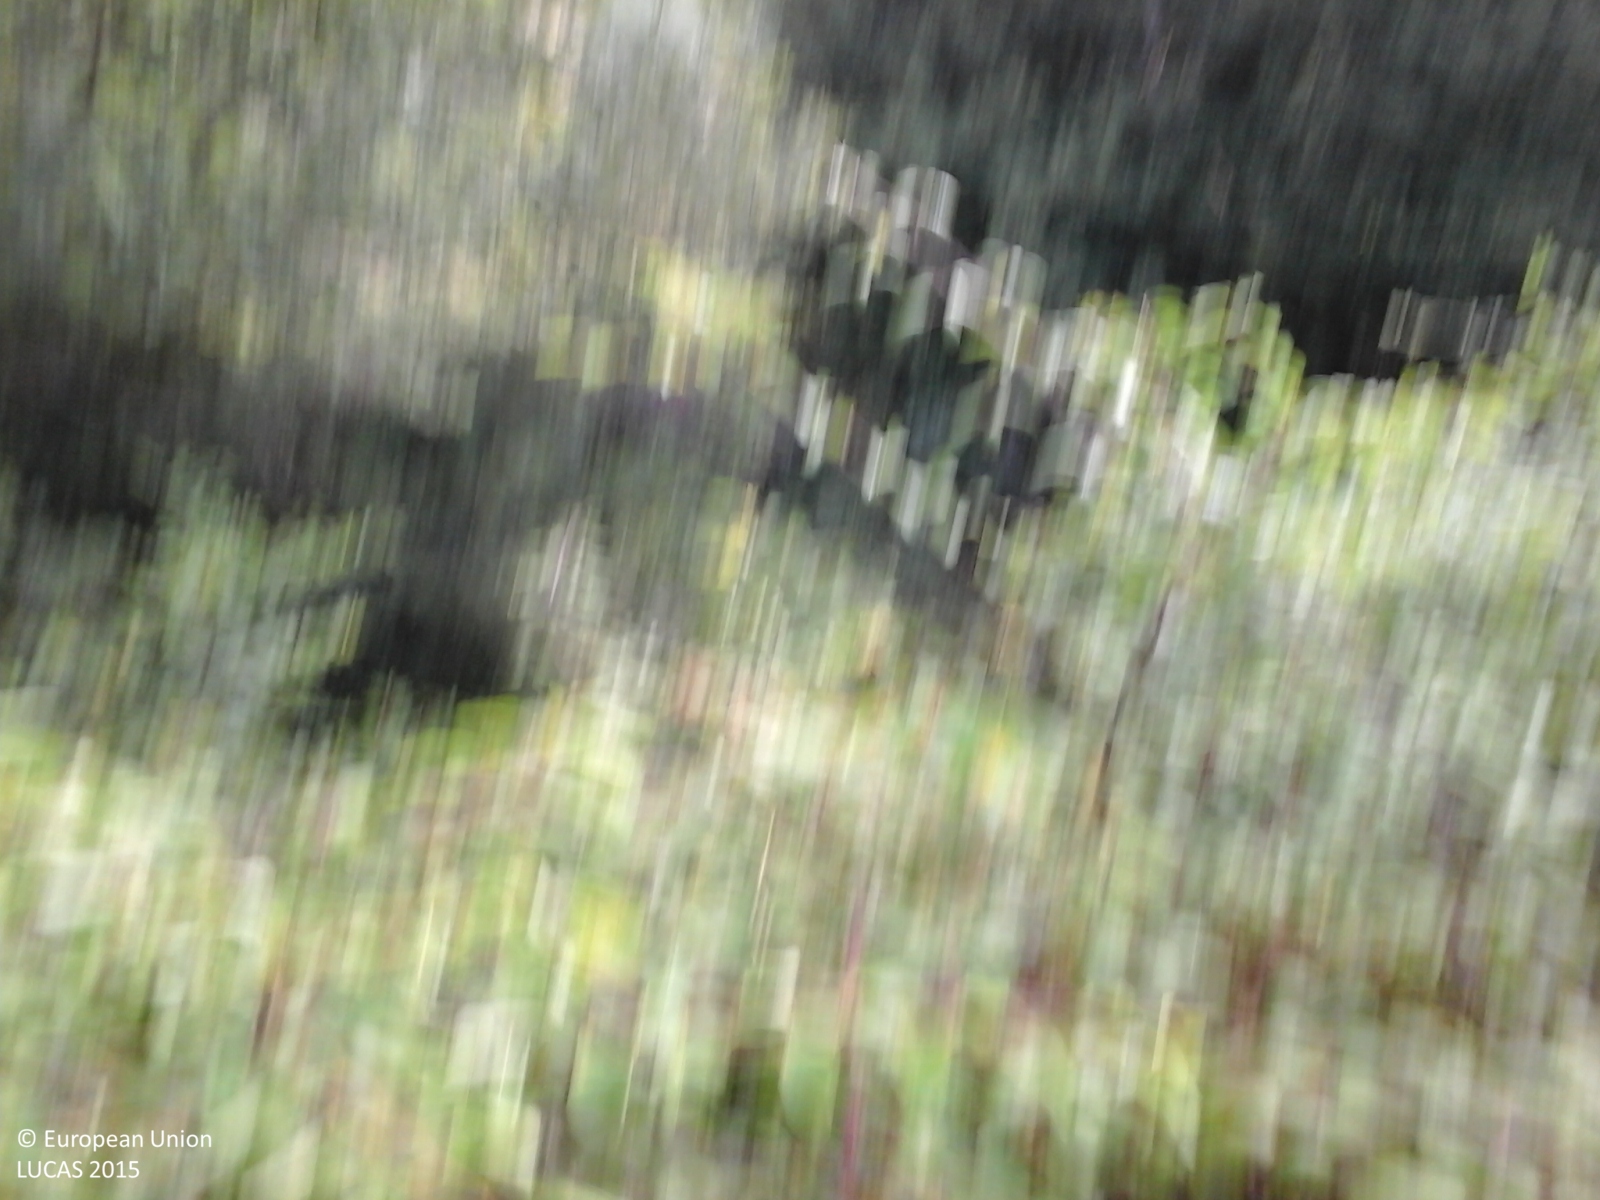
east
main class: Woodland
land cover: Broadleaved woodland
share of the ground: > 75 %
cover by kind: broadleaved forest trees 85 %, shrubs 15 %
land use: Semi-natural and natural areas not in use
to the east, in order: Broadleaved woodland; Ditches and canals; Broadleaved woodland; Olive groves; Temporary grasslands; Tracks; Other bare soil; Abandoned hedges; Other bare soil
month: August
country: IT
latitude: 42.5892
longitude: 11.4695
